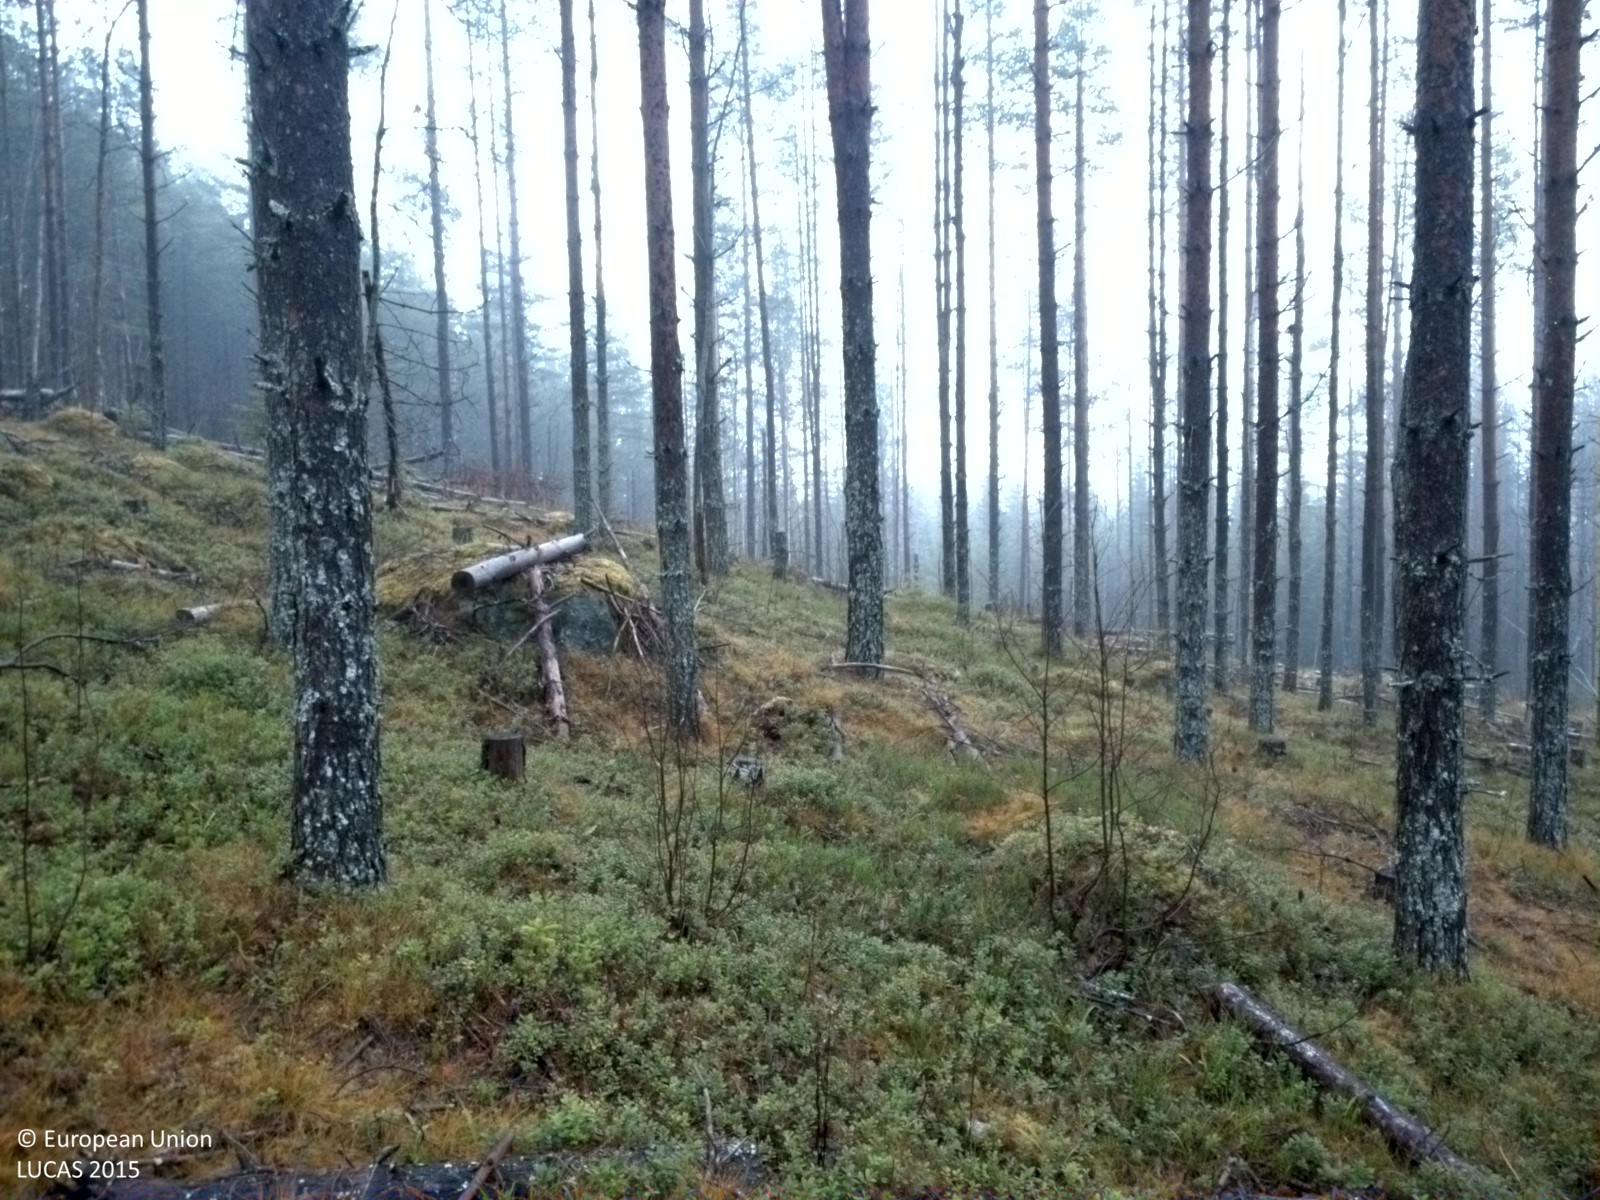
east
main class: Woodland
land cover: Pine dominated coniferous woodland
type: boreal forest
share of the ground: 25 - 50 %
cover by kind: shrubs 40 %, coniferous forest trees 35 %, lichens and mosses 15 %, broadleaved forest trees 5 %, herbaceous plants 5 %
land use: Forestry
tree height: > 5 m
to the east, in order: Pine dominated coniferous woodland; Spruce dominated coniferous woodland; Tracks; Spruce dominated coniferous woodland; Broadleaved woodland; Inland fresh water bodies
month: November
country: SE
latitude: 64.0292
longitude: 16.0501
